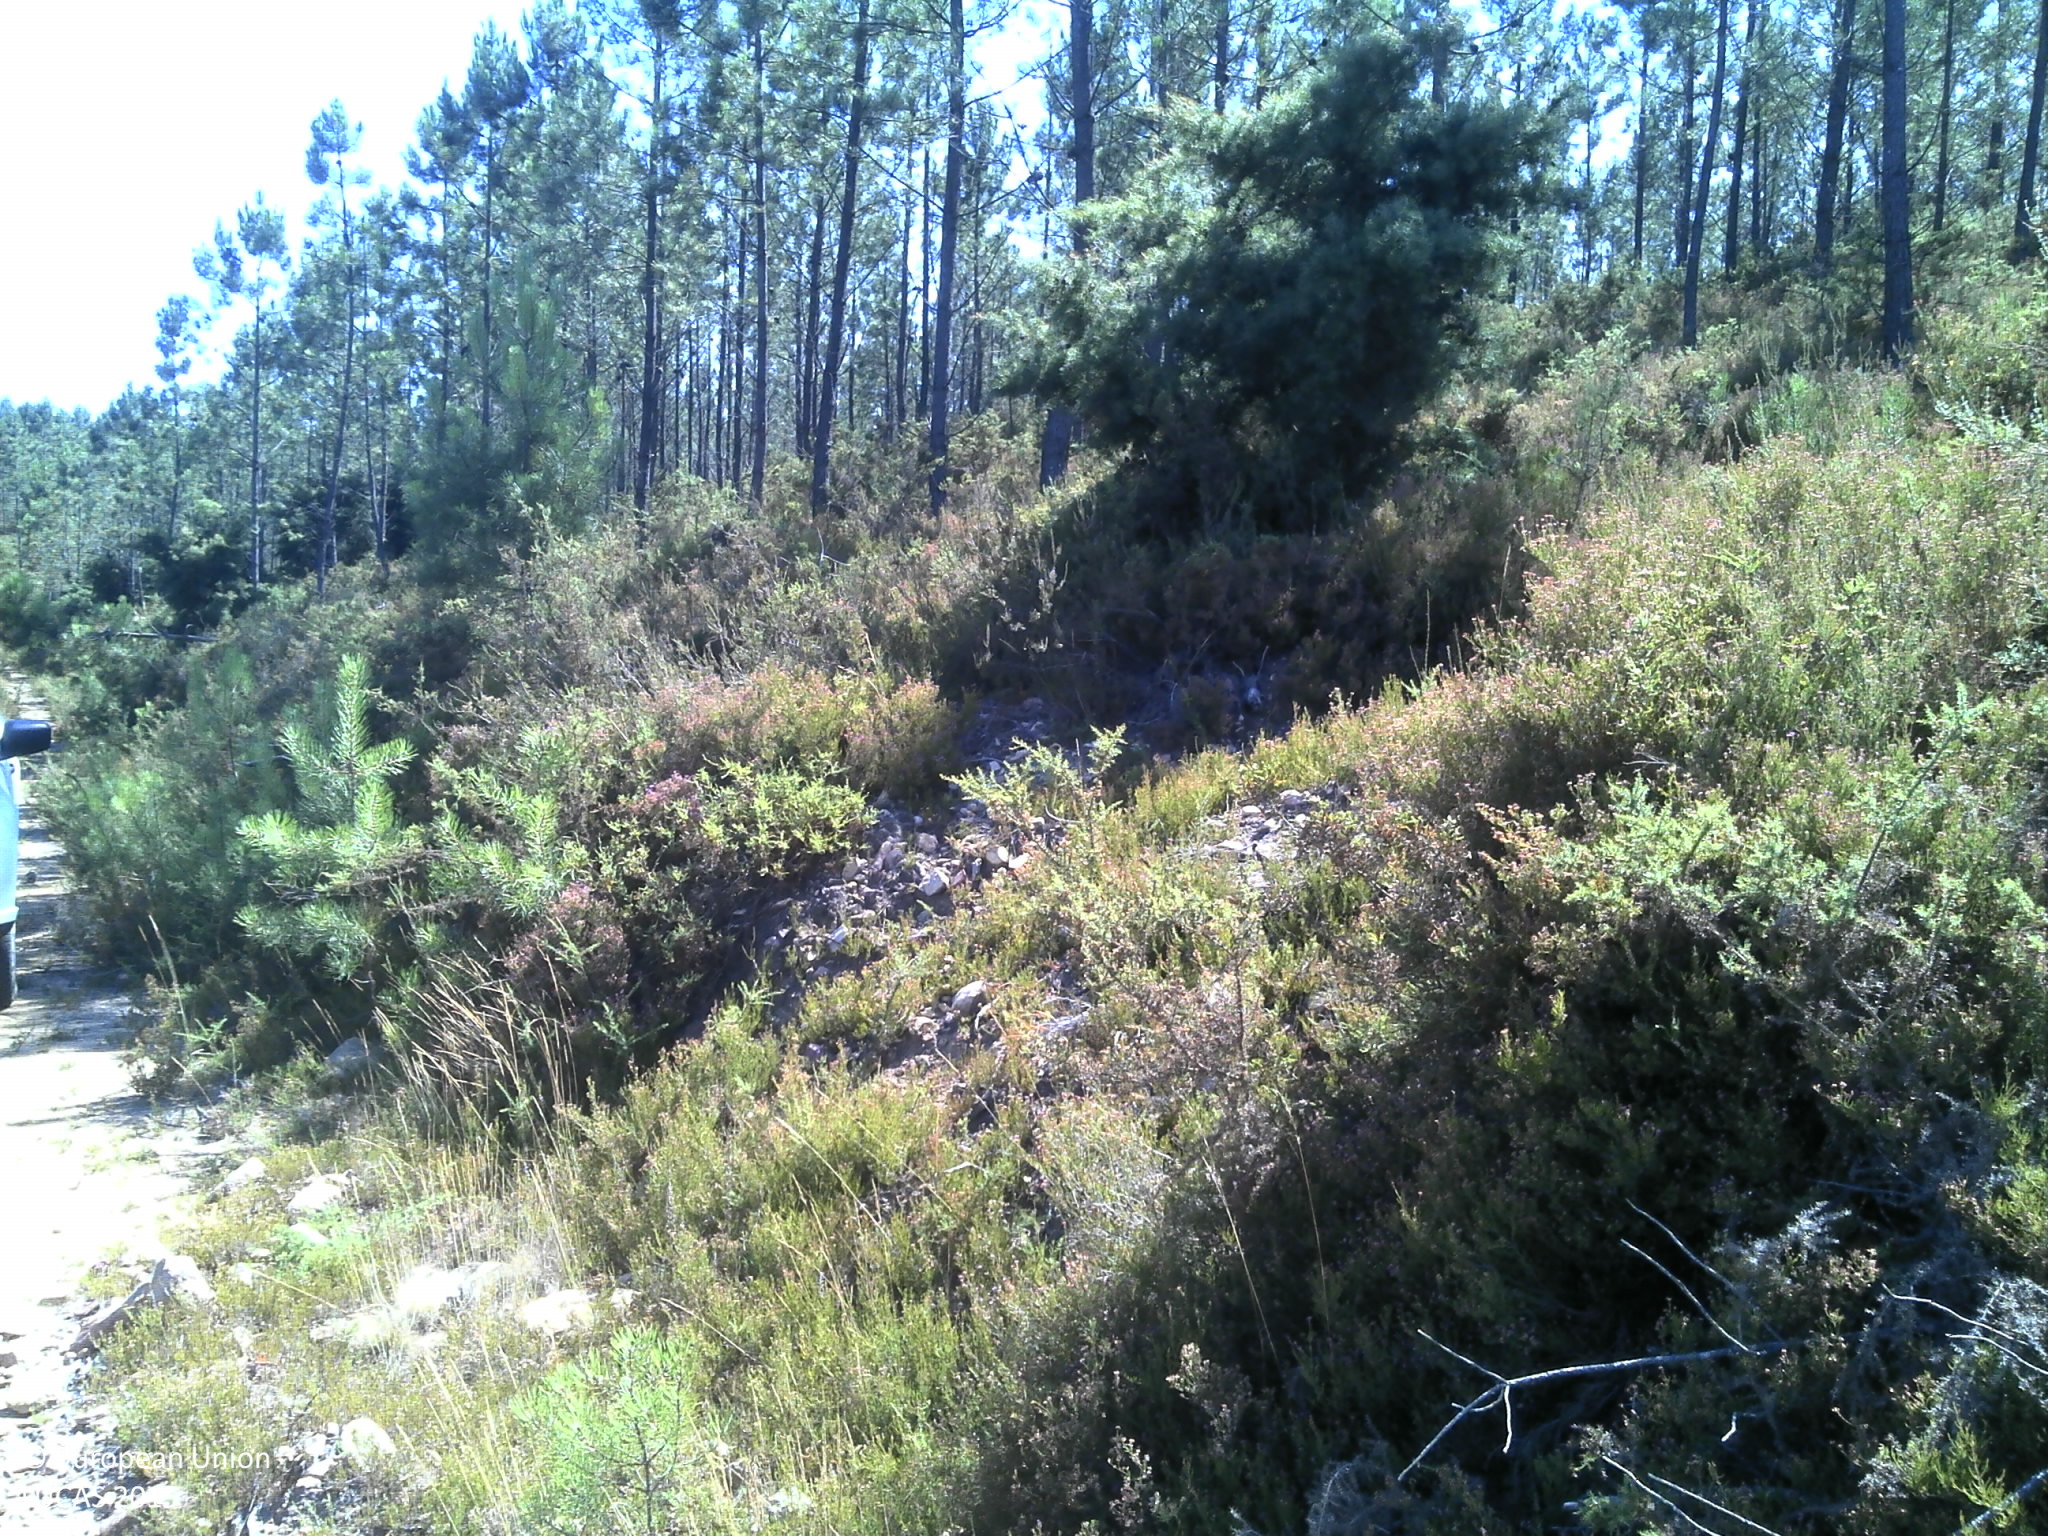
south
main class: Woodland
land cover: Pine dominated coniferous woodland
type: coniferous forest of the mediterranean region
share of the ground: 50 - 75 %
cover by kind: coniferous forest trees 50 %, shrubs 40 %, unconsolidated bare surface 10 %
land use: Forestry
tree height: > 5 m
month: July
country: PT
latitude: 40.2463
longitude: -8.2172
